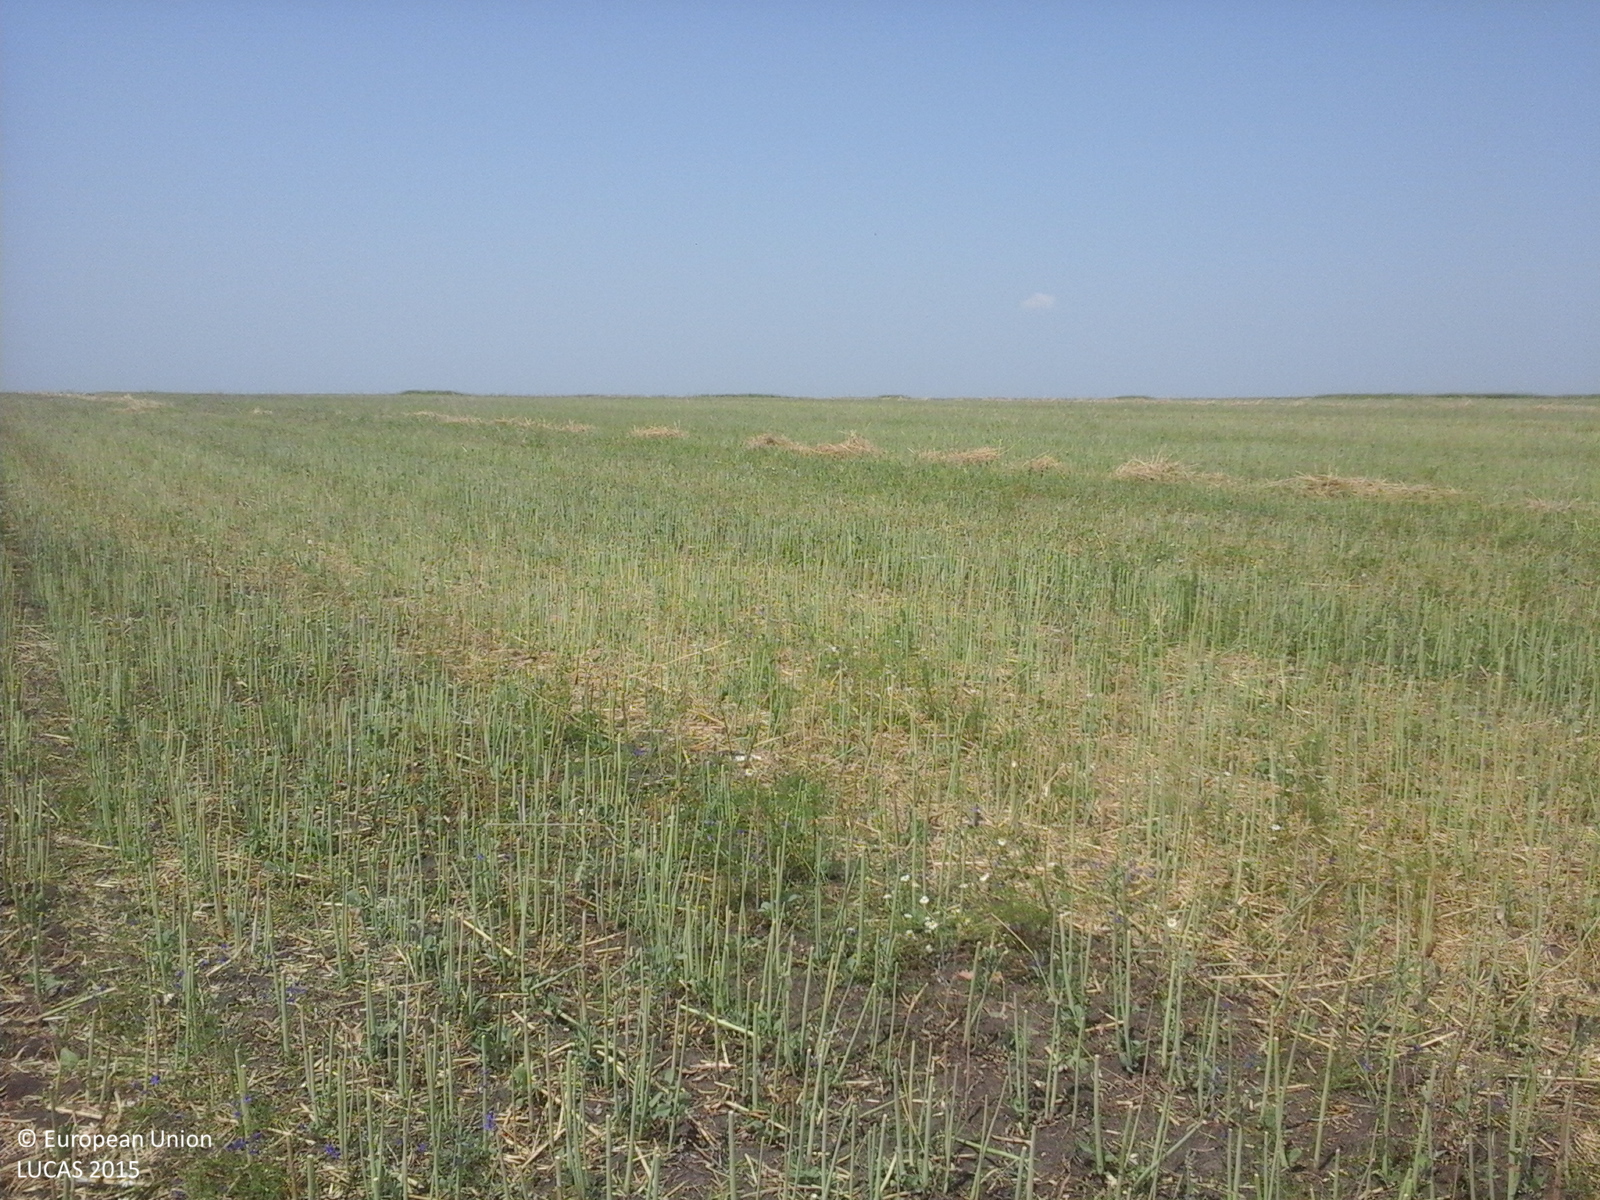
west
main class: Cropland
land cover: Rape and turnip rape
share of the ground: 10 - 25 %
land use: Agriculture (excluding fallow land and kitchen gardens)
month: July
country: RO
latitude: 44.4518
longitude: 24.8175
